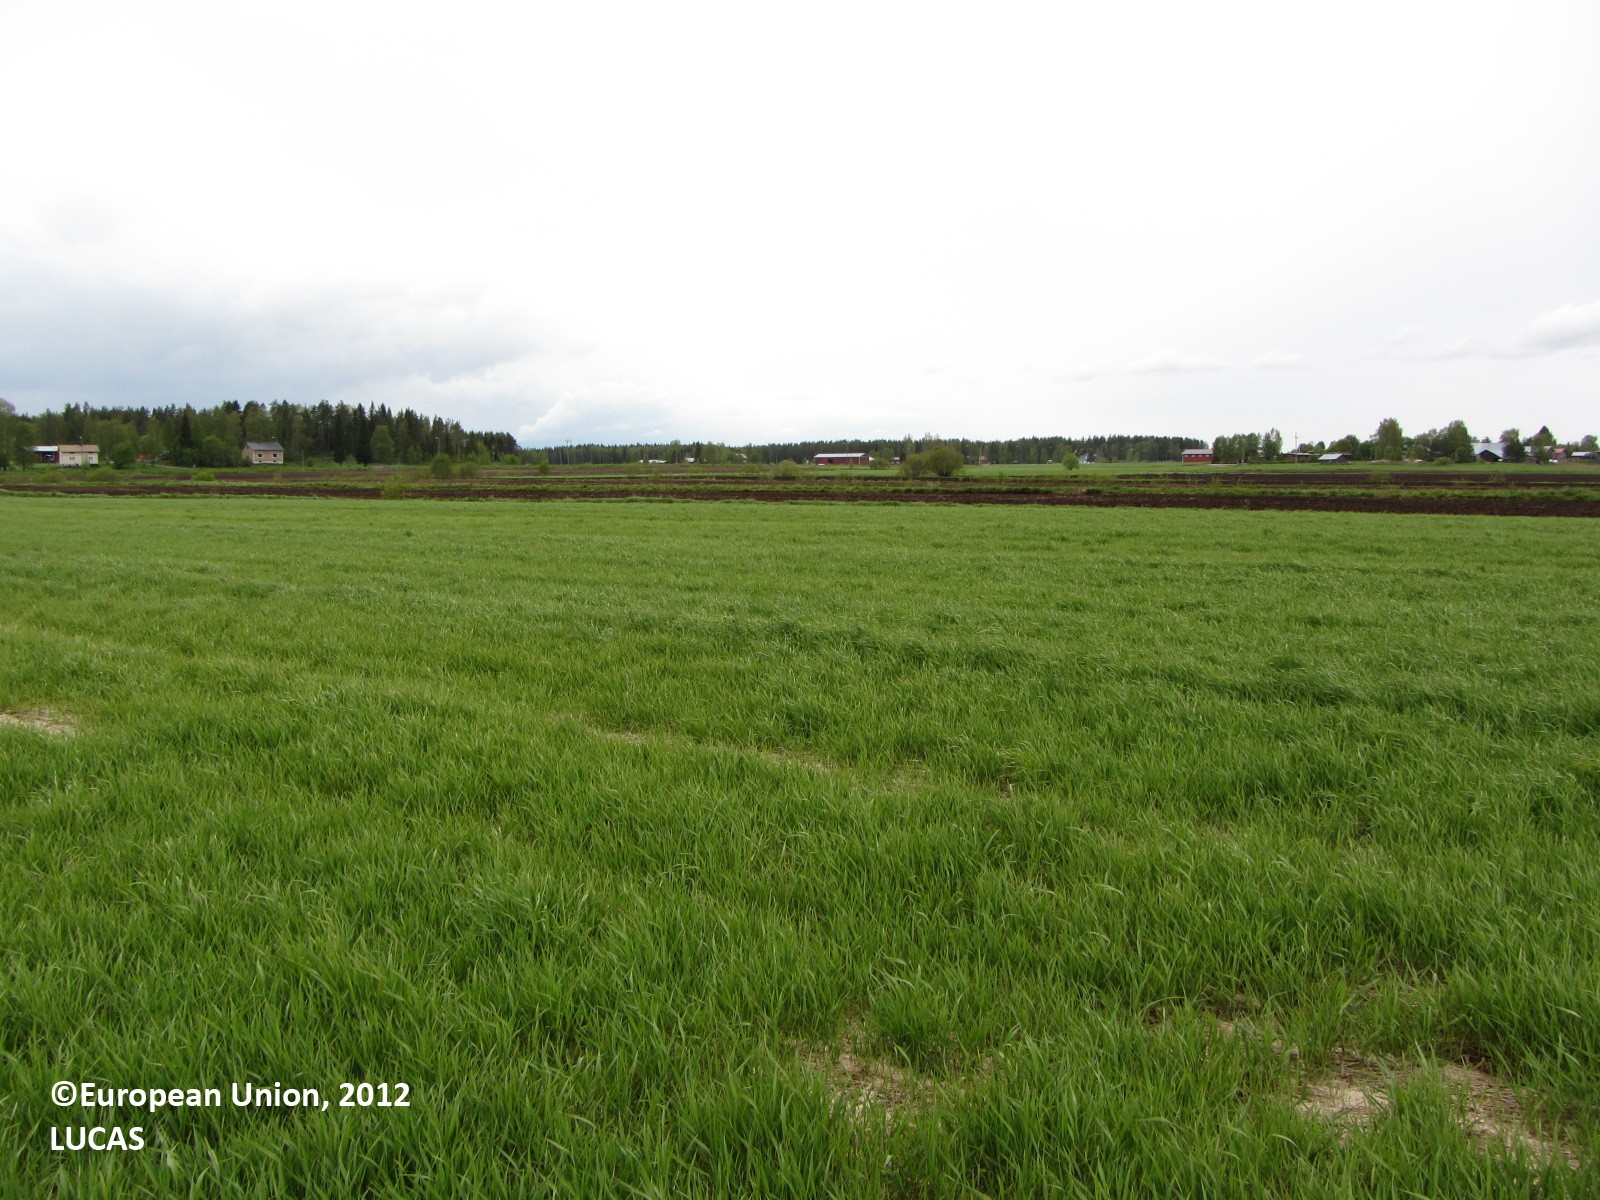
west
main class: Cropland
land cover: Barley
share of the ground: > 75 %
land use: Agriculture (excluding fallow land and kitchen gardens)
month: June
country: FI
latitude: 63.8240
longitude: 24.6476
